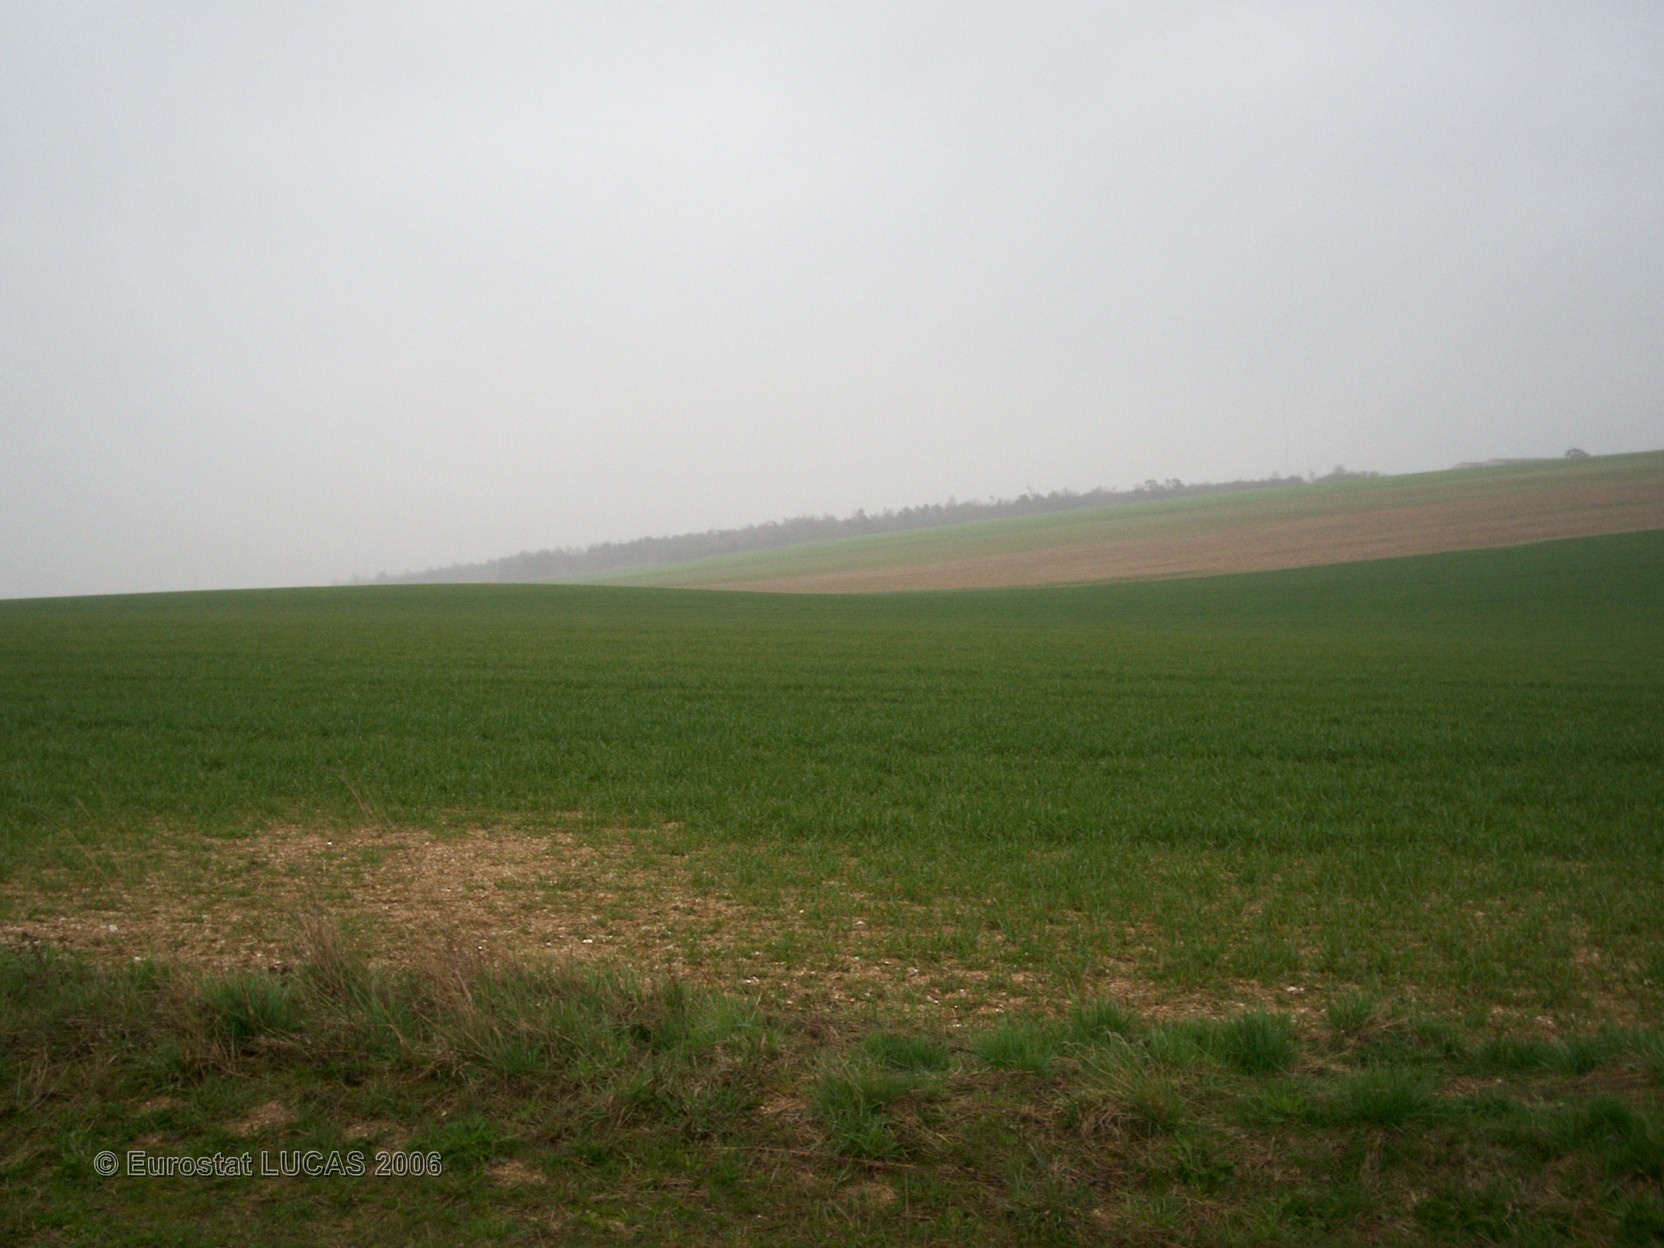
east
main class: Cropland
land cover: Common wheat
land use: Agriculture (excluding fallow land and kitchen gardens)
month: April
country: FR
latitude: 49.2564
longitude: 4.4592
